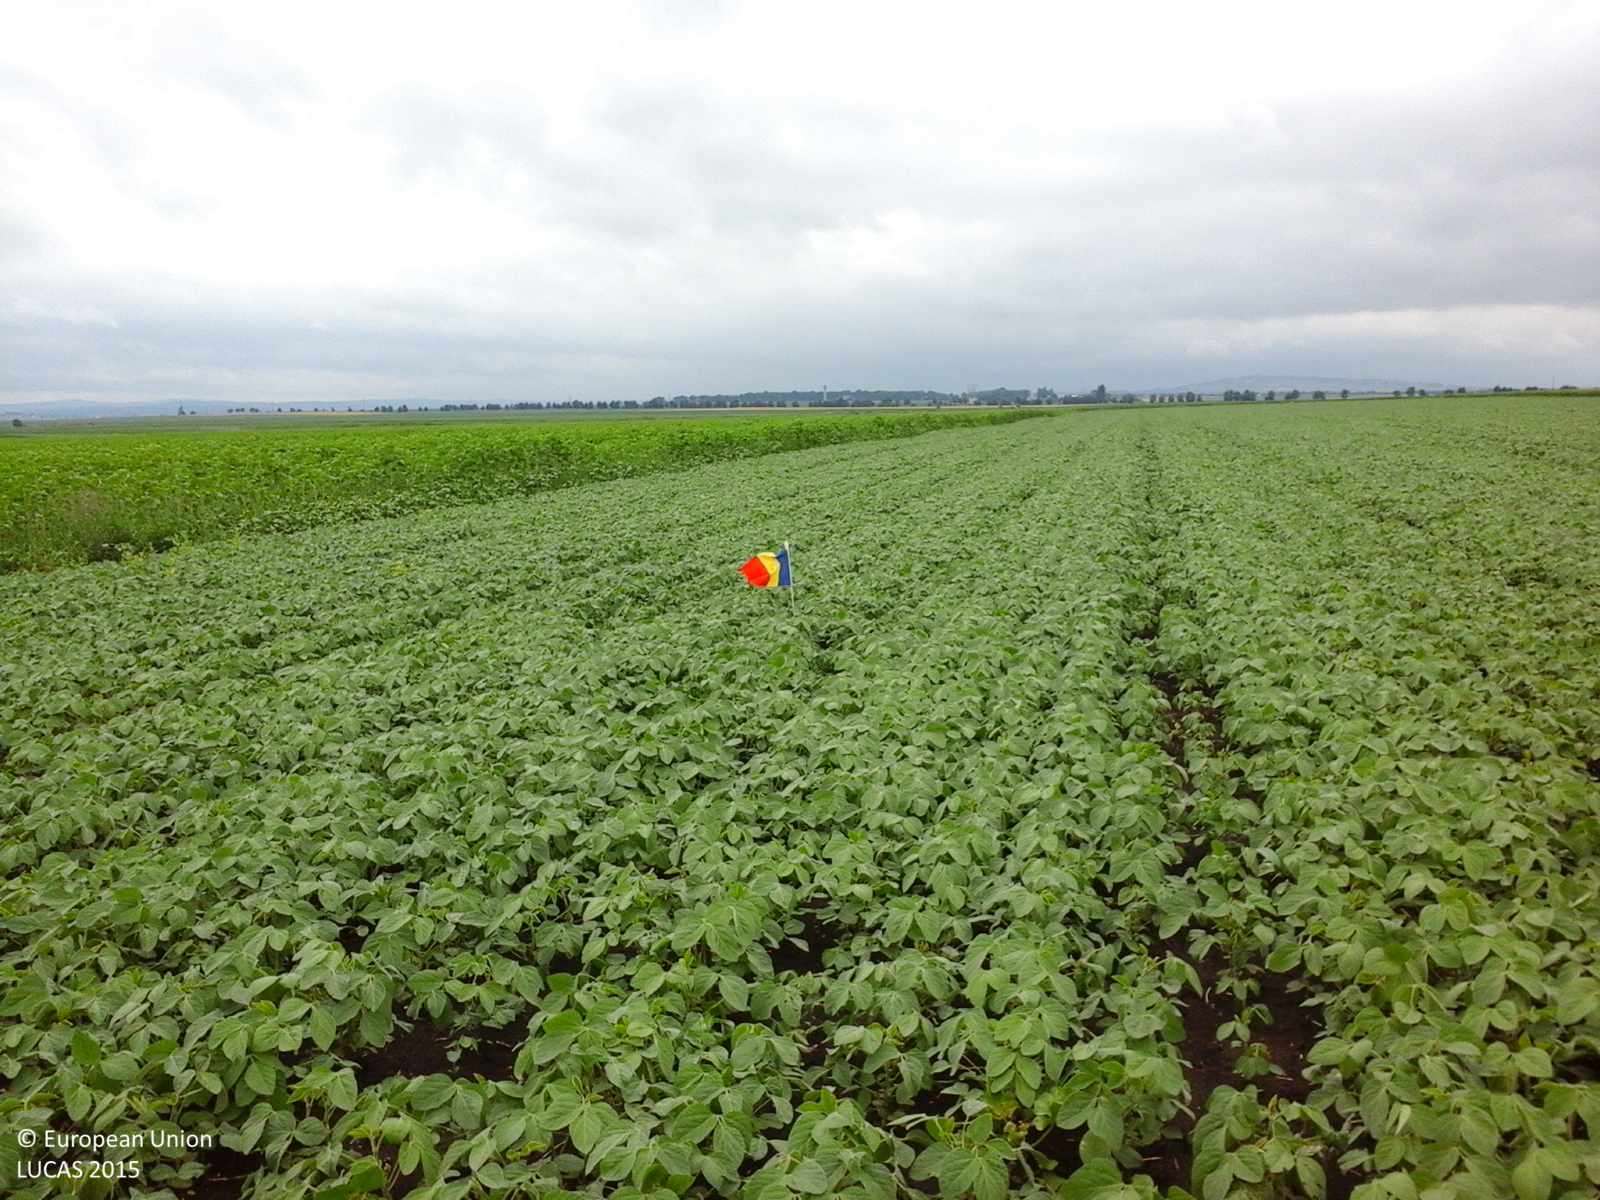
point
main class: Cropland
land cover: Soya
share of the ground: > 75 %
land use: Agriculture (excluding fallow land and kitchen gardens)
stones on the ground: < 10 %
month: June
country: RO
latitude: 47.9823
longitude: 26.4771
